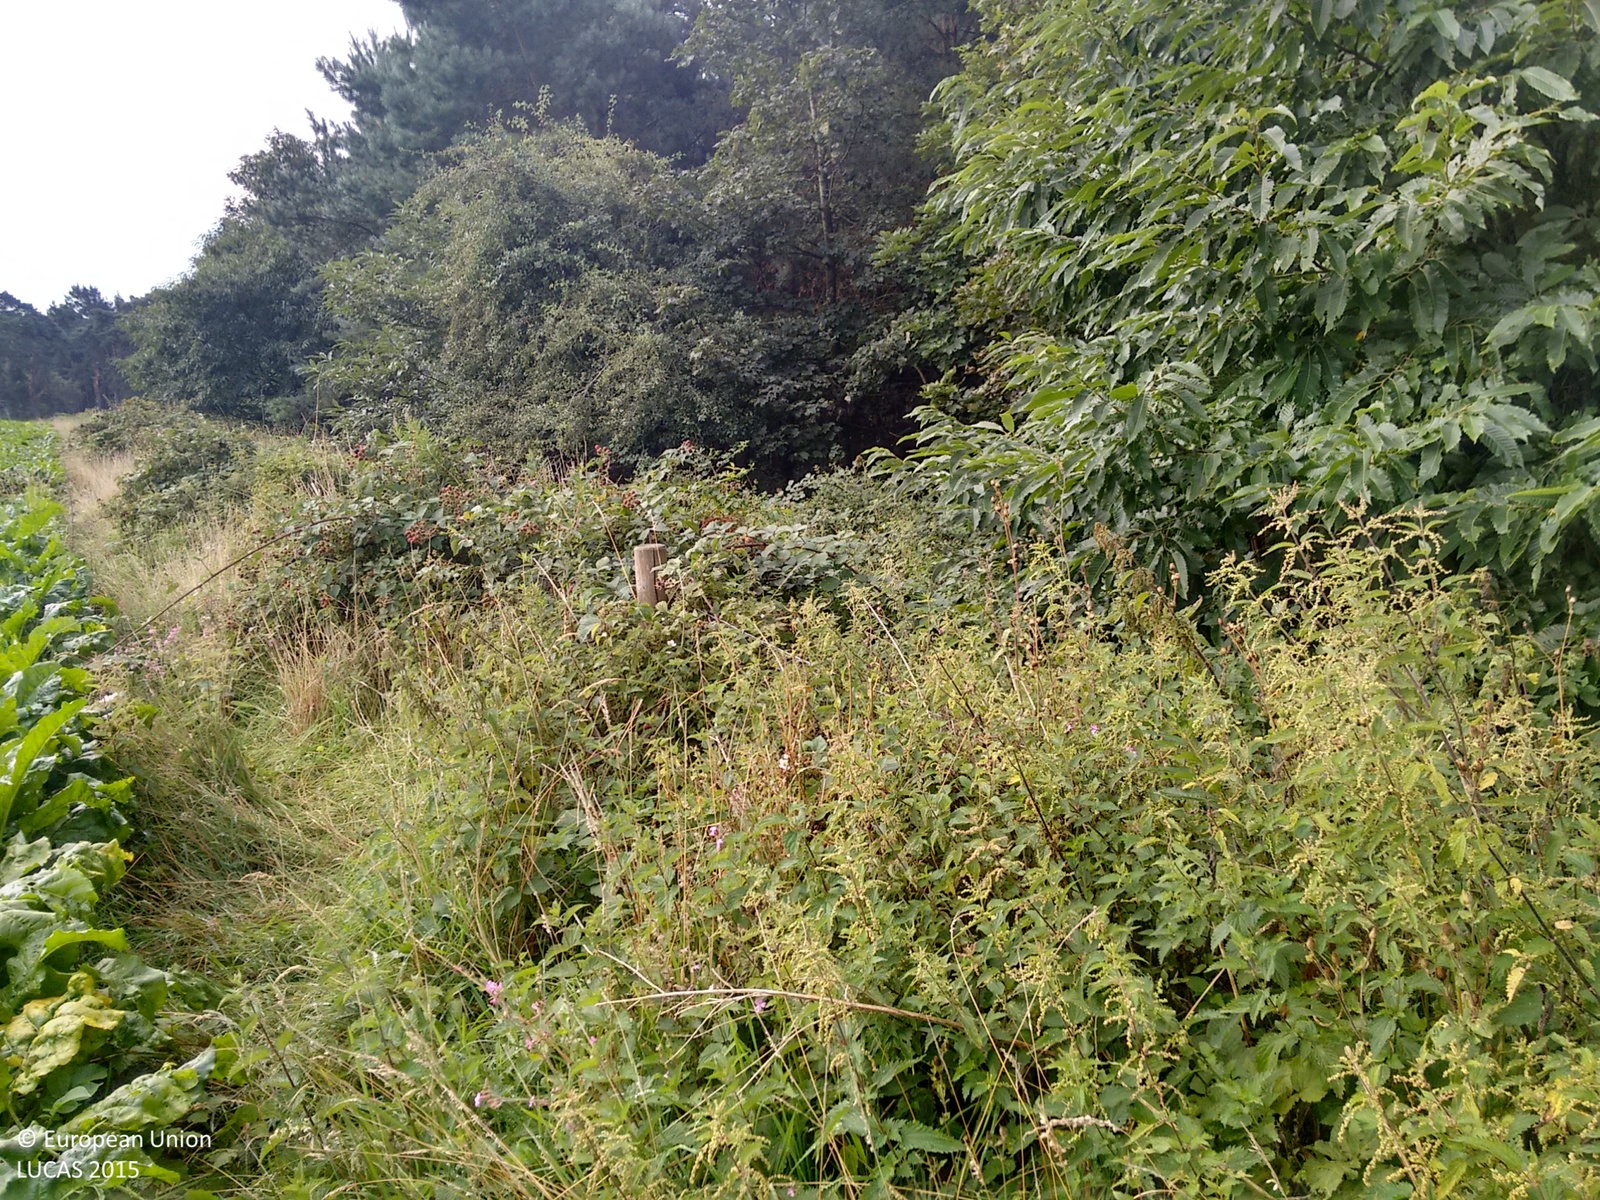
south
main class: Cropland
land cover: Sugar beet
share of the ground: > 75 %
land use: Agriculture (excluding fallow land and kitchen gardens)
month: August
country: GB
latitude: 52.0641
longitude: 1.3883
